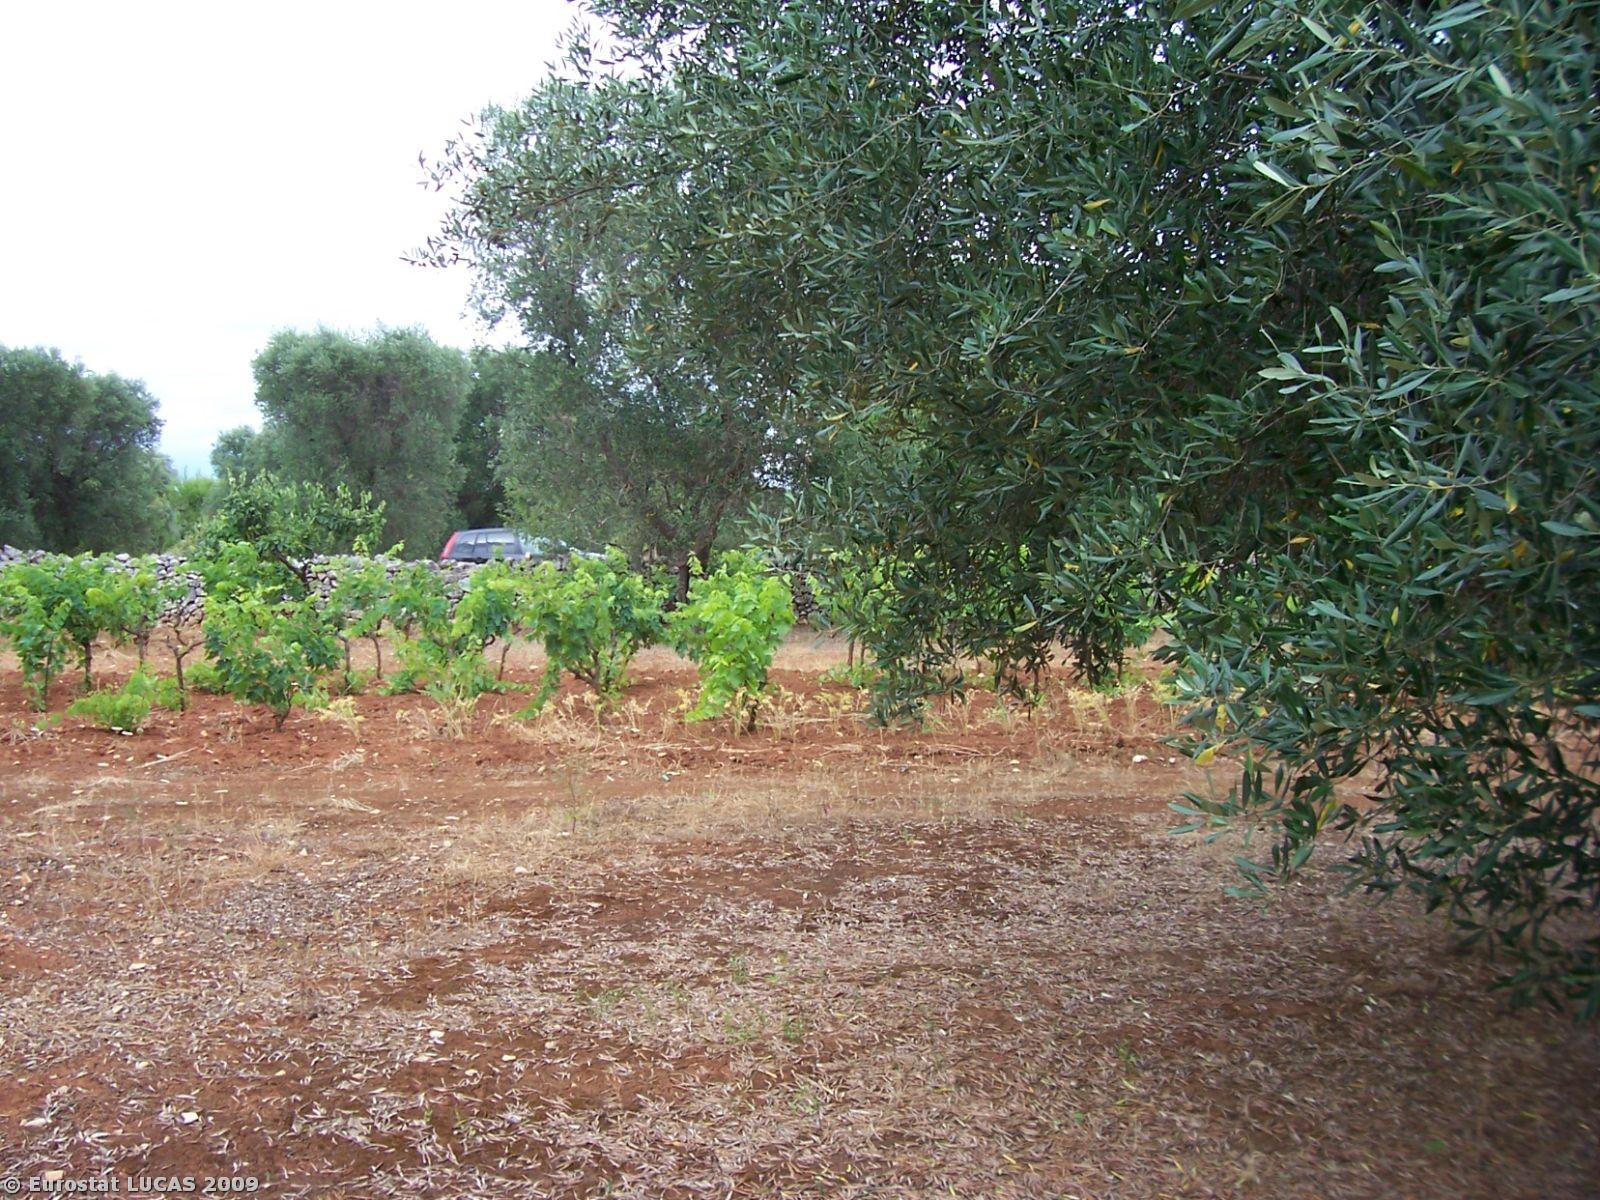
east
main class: Cropland
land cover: Olive groves
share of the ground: 25 - 50 %
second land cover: Bare land
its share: > 75 %
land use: Agriculture (excluding fallow land and kitchen gardens)
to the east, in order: Olive groves; Bare land; Dry stone walls; Grass margins; Paved roads, cycling and walking lanes; Grass margins; Fences; Vineyards; Bare land; Fences; Olive groves; Bare land; Vineyards; Bare land; Olive groves; Bare land; Tracks; Olive groves; Bare land; Vineyards; Bare land; Grass margins; Fences; Lines of trees; Artificial constructions in urban areas; Lines of trees; Fences; Grass margins; Nuts trees; Bare land; Olive groves; Bare land
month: June
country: IT
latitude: 40.3957
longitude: 17.5271
